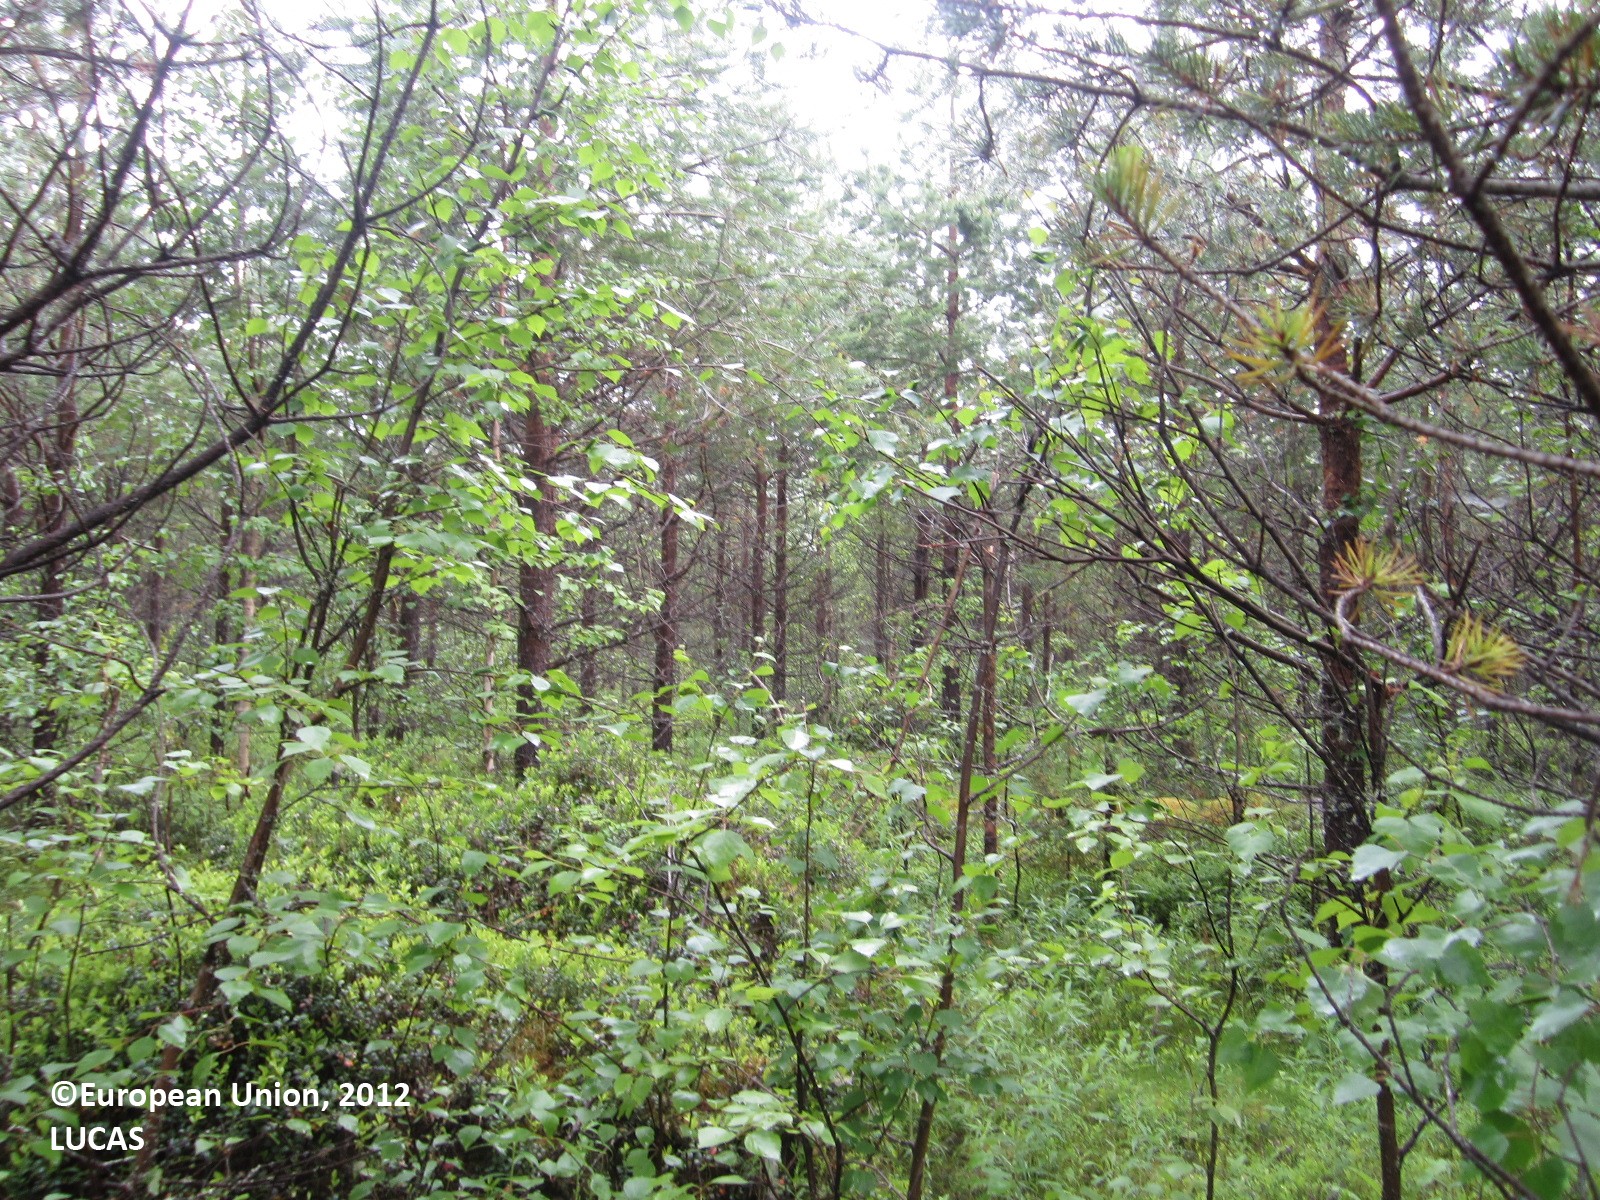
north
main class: Woodland
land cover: Pine dominated coniferous woodland
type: boreal forest
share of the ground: > 75 %
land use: Forestry
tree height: > 5 m
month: June
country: FI
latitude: 64.5097
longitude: 29.5630
